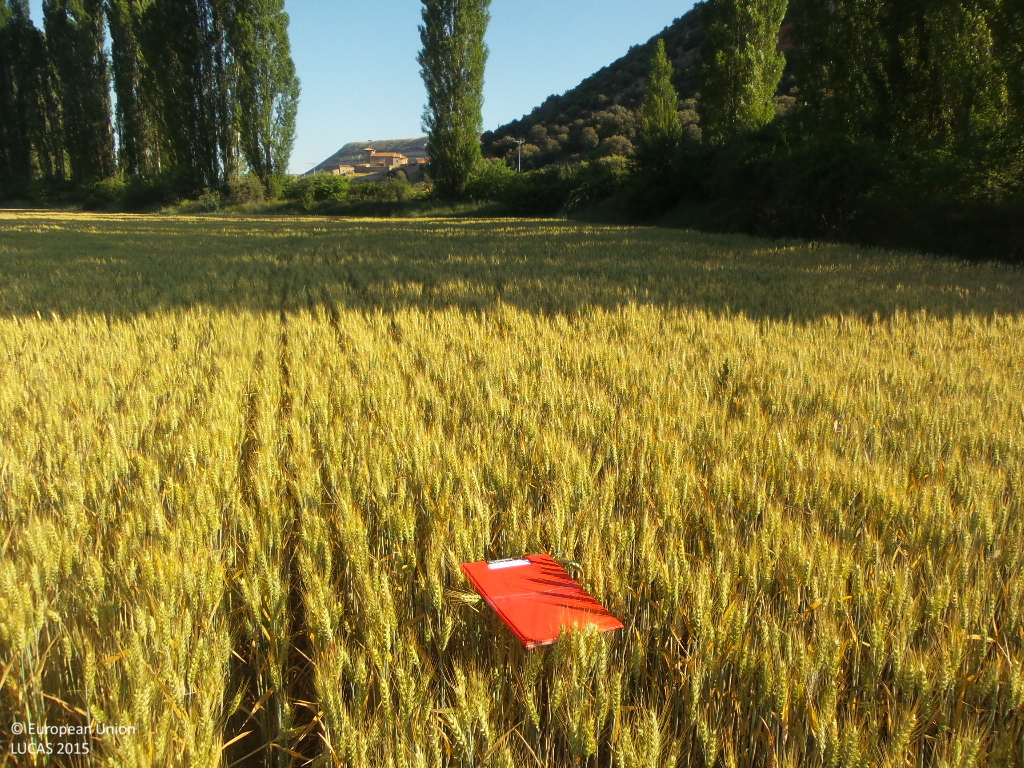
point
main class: Cropland
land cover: Common wheat
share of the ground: > 75 %
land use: Agriculture (excluding fallow land and kitchen gardens)
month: June
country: ES
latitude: 41.3733
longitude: -2.7222
